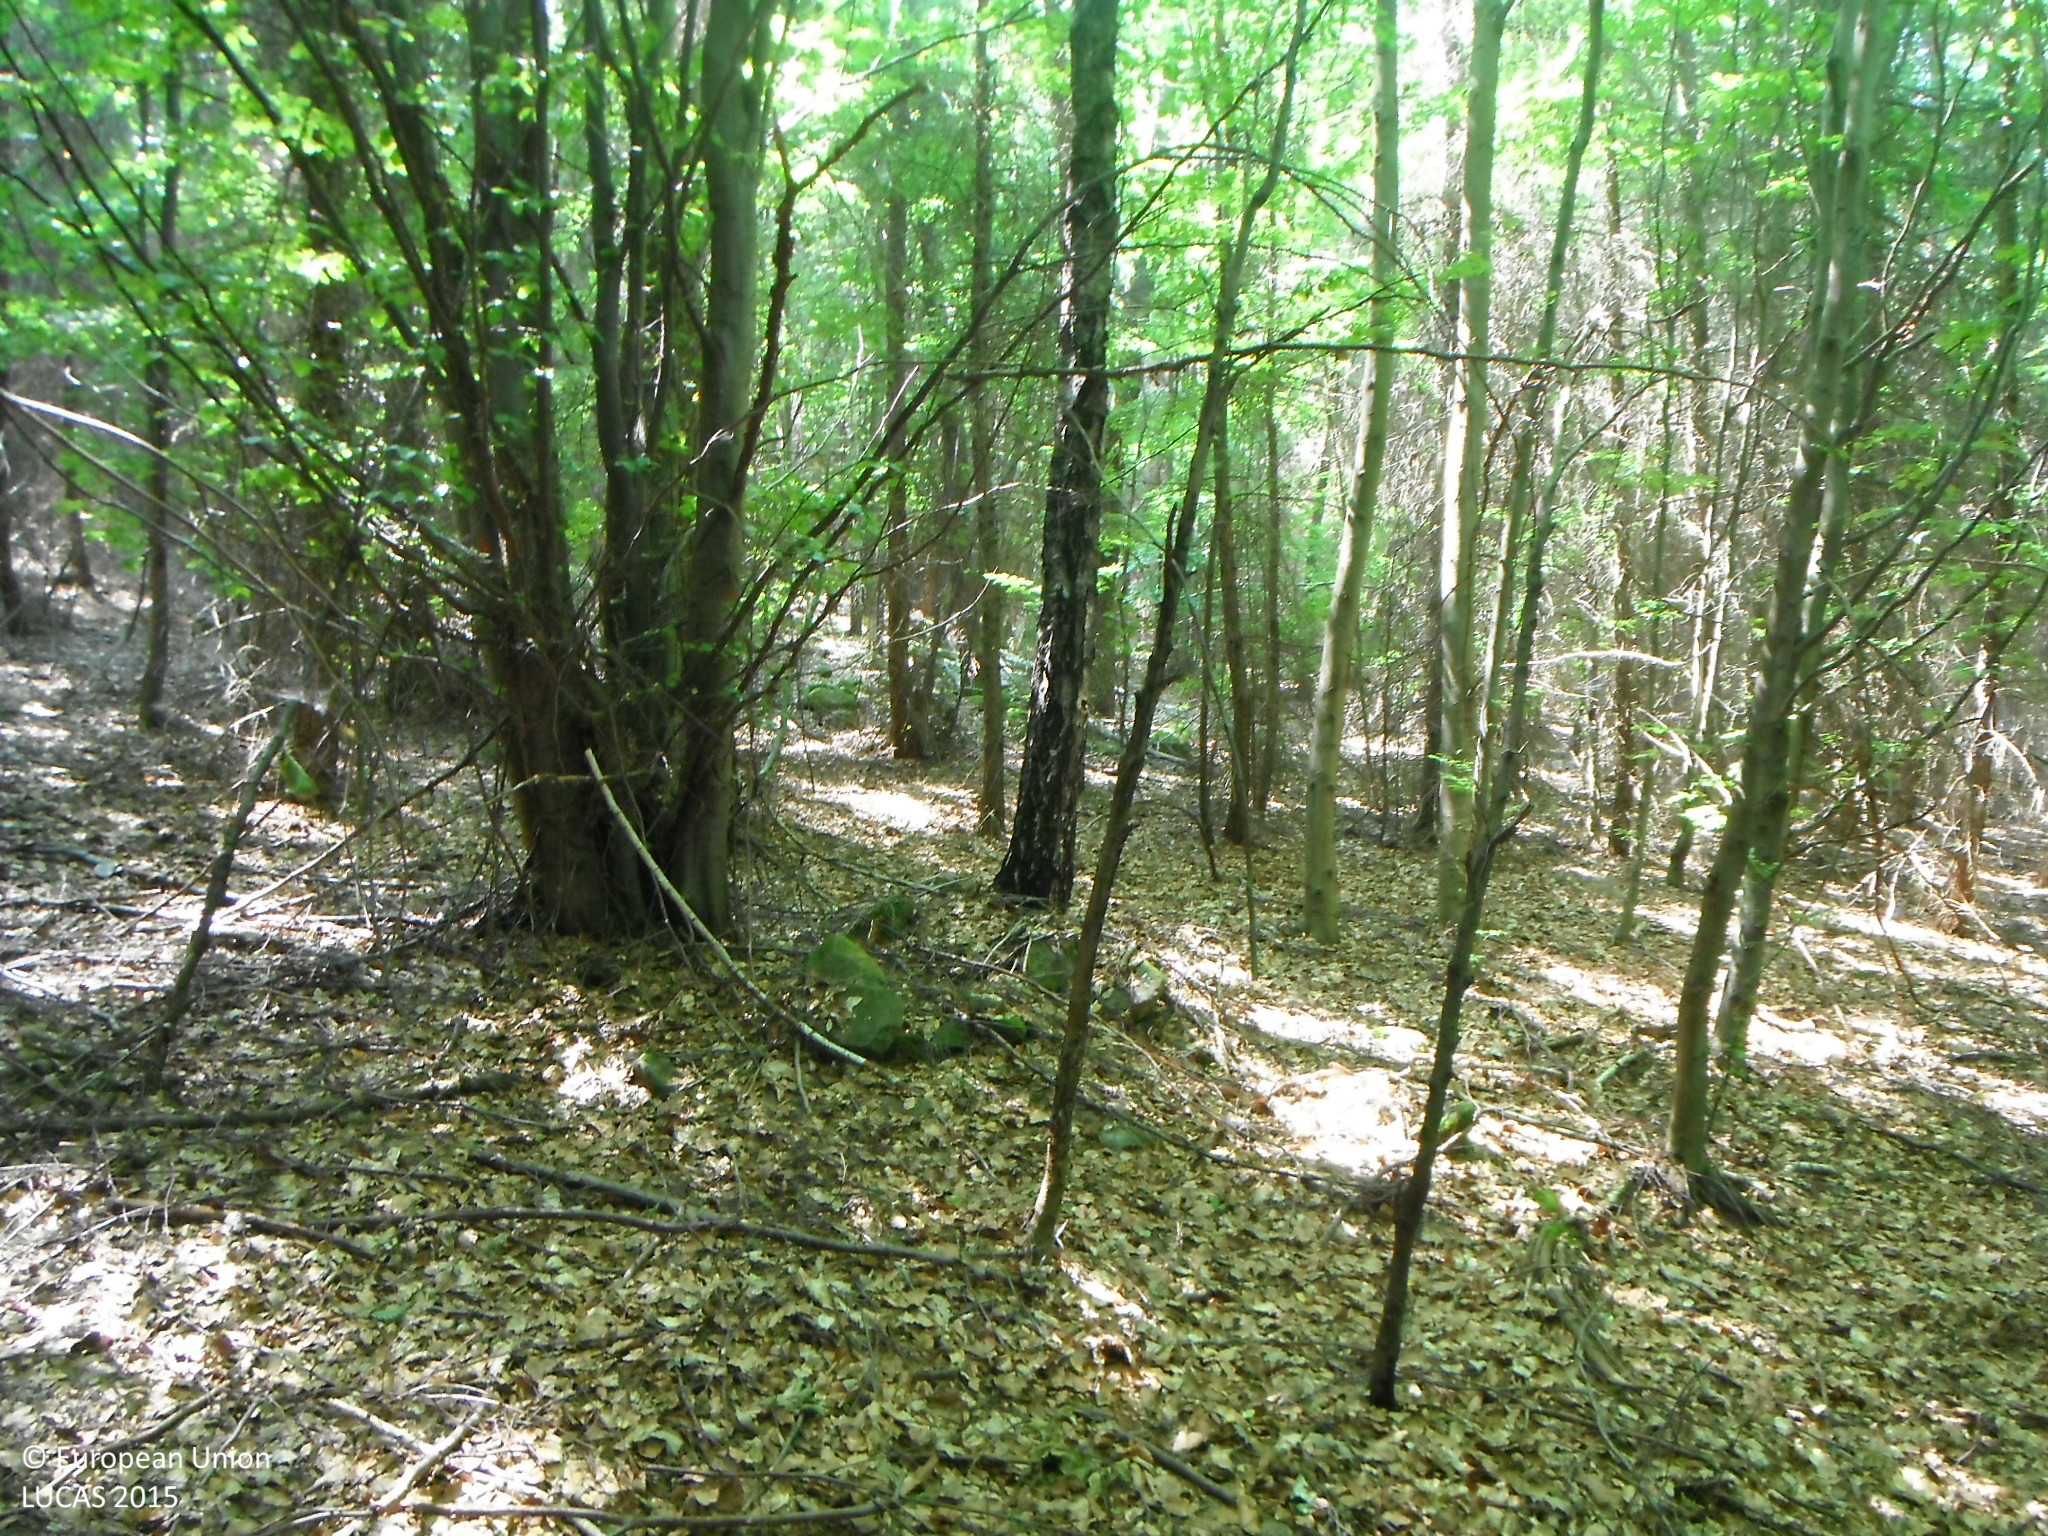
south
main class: Woodland
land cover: Spruce dominated mixed woodland
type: alpine coniferous forest
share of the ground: > 75 %
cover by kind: coniferous forest trees 50 %, broadleaved forest trees 50 %
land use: Forestry
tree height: > 5 m
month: July
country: SK
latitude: 48.5115
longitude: 19.1592
